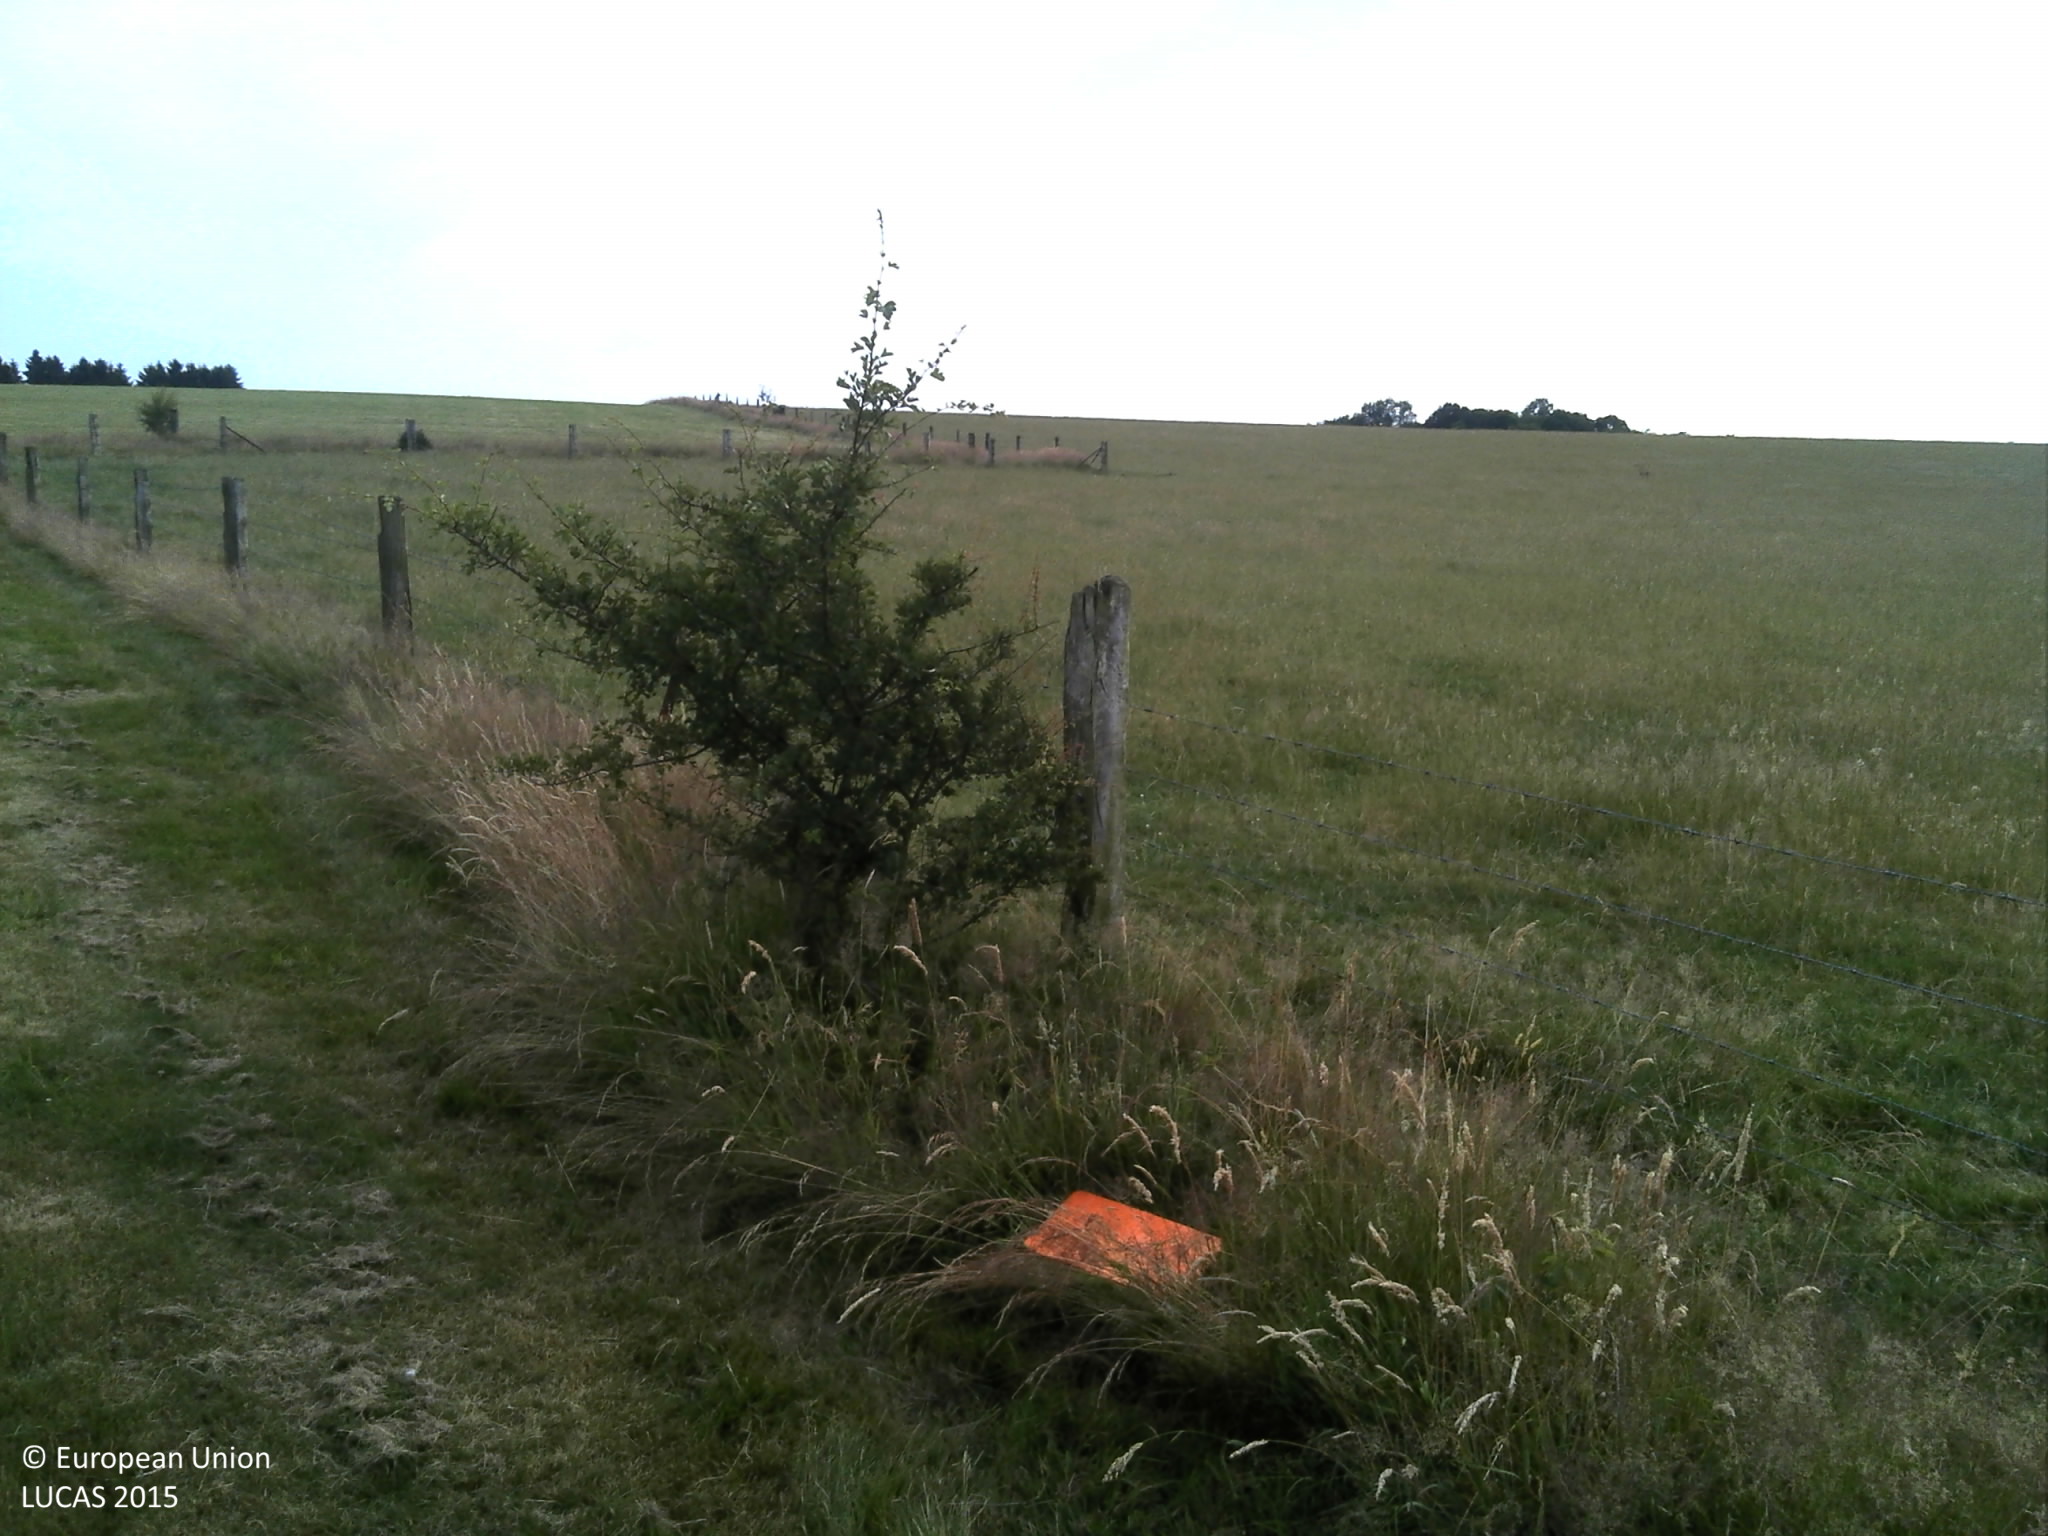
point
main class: Grassland
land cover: Grassland without tree/shrub cover
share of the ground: > 75 %
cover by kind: herbaceous plants 100 %
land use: Agriculture (excluding fallow land and kitchen gardens)
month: July
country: FR
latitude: 49.8613
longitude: 4.6686
